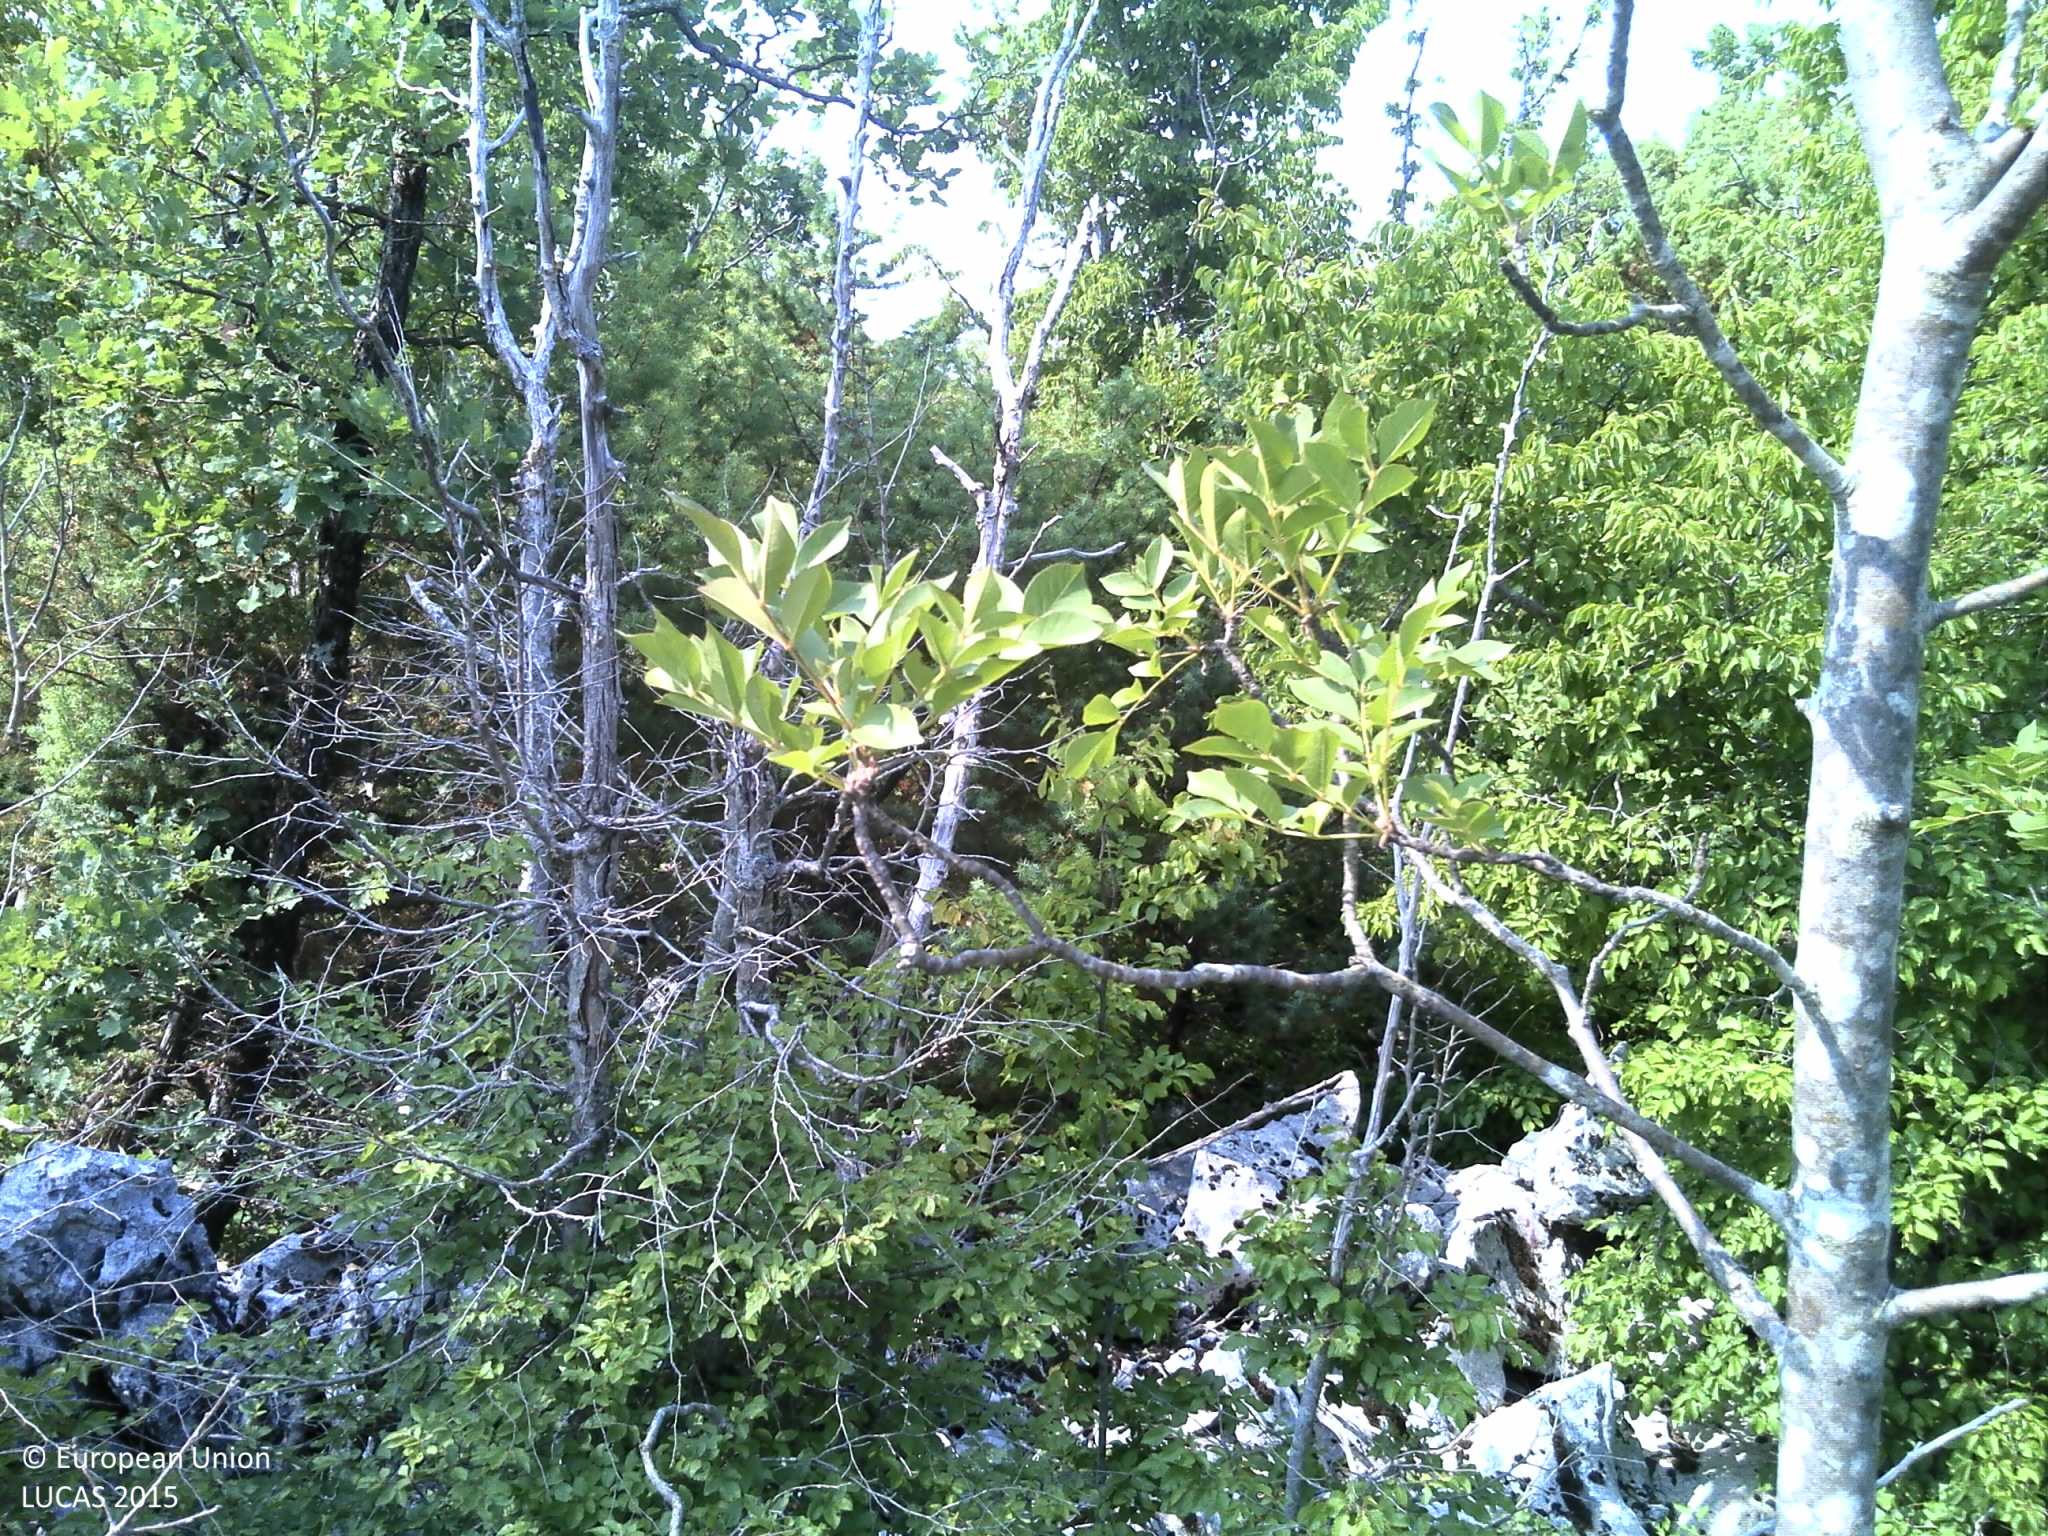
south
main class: Woodland
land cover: Other mixed woodland
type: thermophilous deciduous forest
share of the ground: > 75 %
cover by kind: broadleaved forest trees 45 %, coniferous forest trees 30 %, shrubs 10 %, consolidated bare surface 10 %, herbaceous plants 5 %
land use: Semi-natural and natural areas not in use
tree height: > 5 m
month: July
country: HR
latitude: 43.4853
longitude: 16.9280
